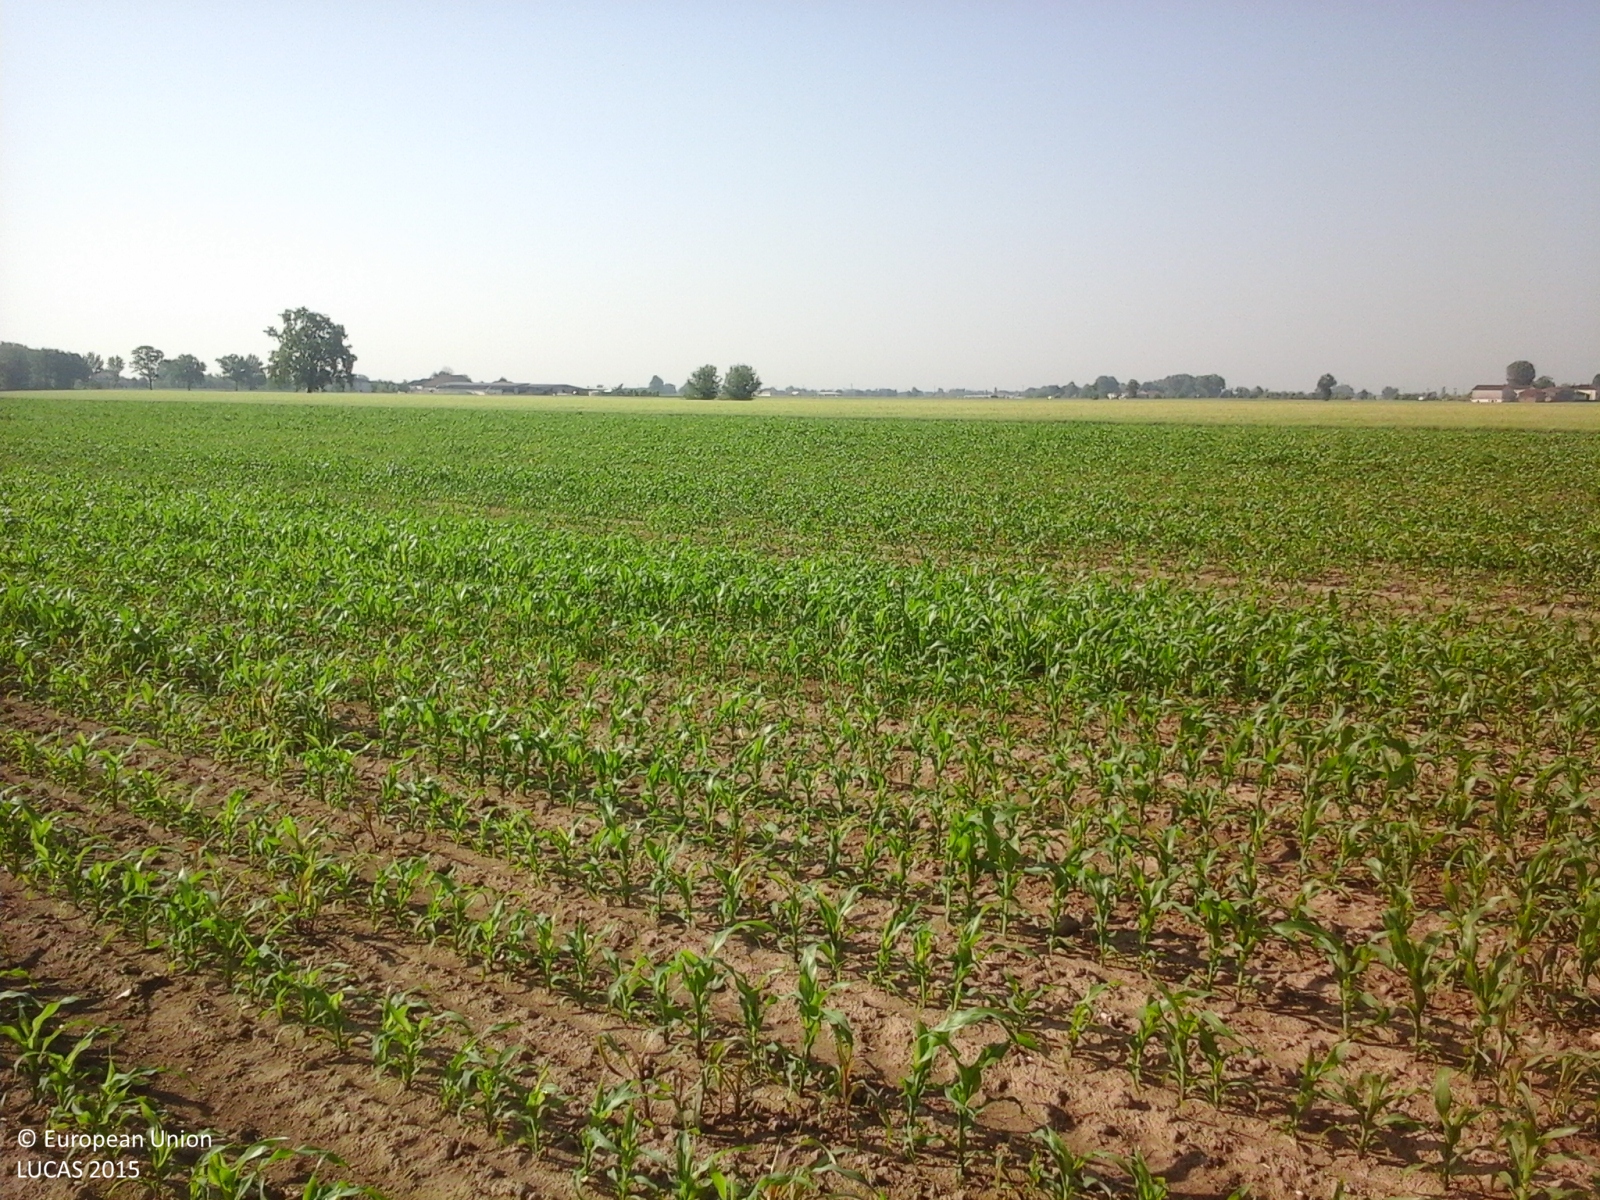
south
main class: Cropland
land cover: Maize
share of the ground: 25 - 50 %
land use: Agriculture (excluding fallow land and kitchen gardens)
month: May
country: IT
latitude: 45.1240
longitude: 10.6218
